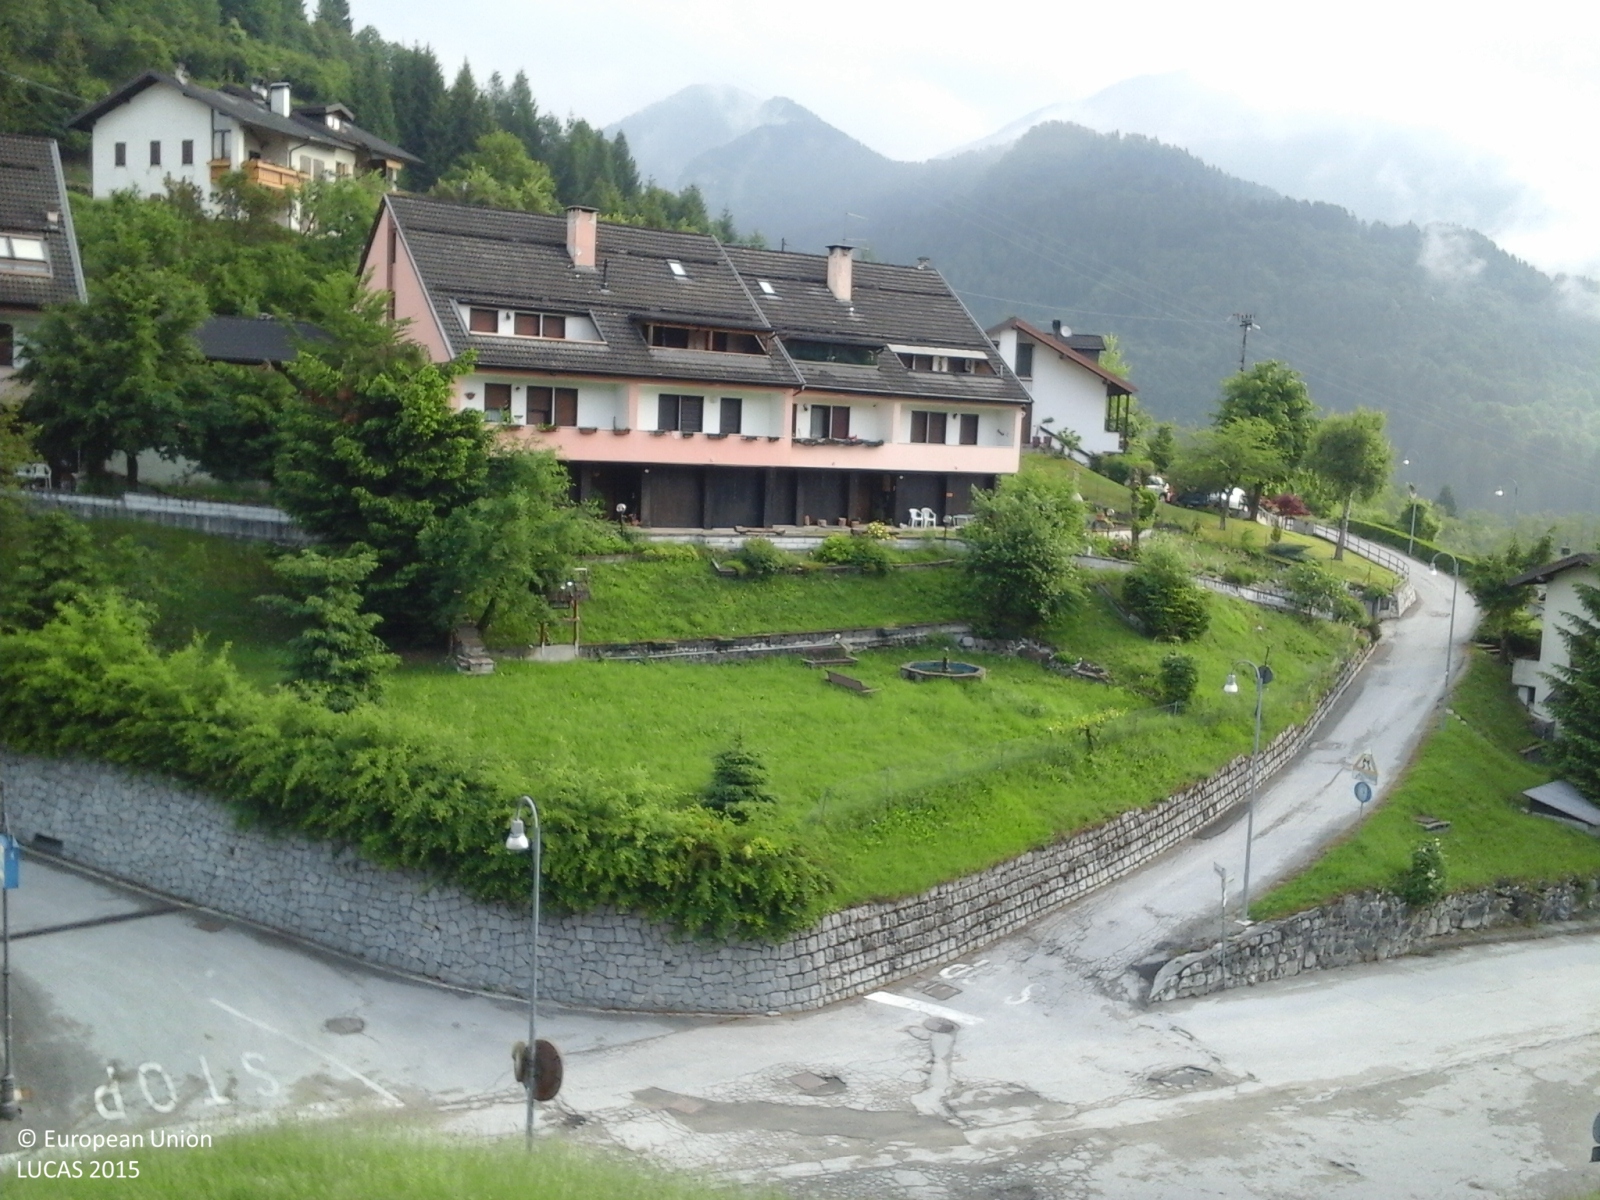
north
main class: Grassland
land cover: Grassland without tree/shrub cover
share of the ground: > 75 %
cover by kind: herbaceous plants 90 %, consolidated bare surface 5 %, unconsolidated bare surface 5 %
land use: Agriculture (excluding fallow land and kitchen gardens)
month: May
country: IT
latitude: 46.0688
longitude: 11.6138
